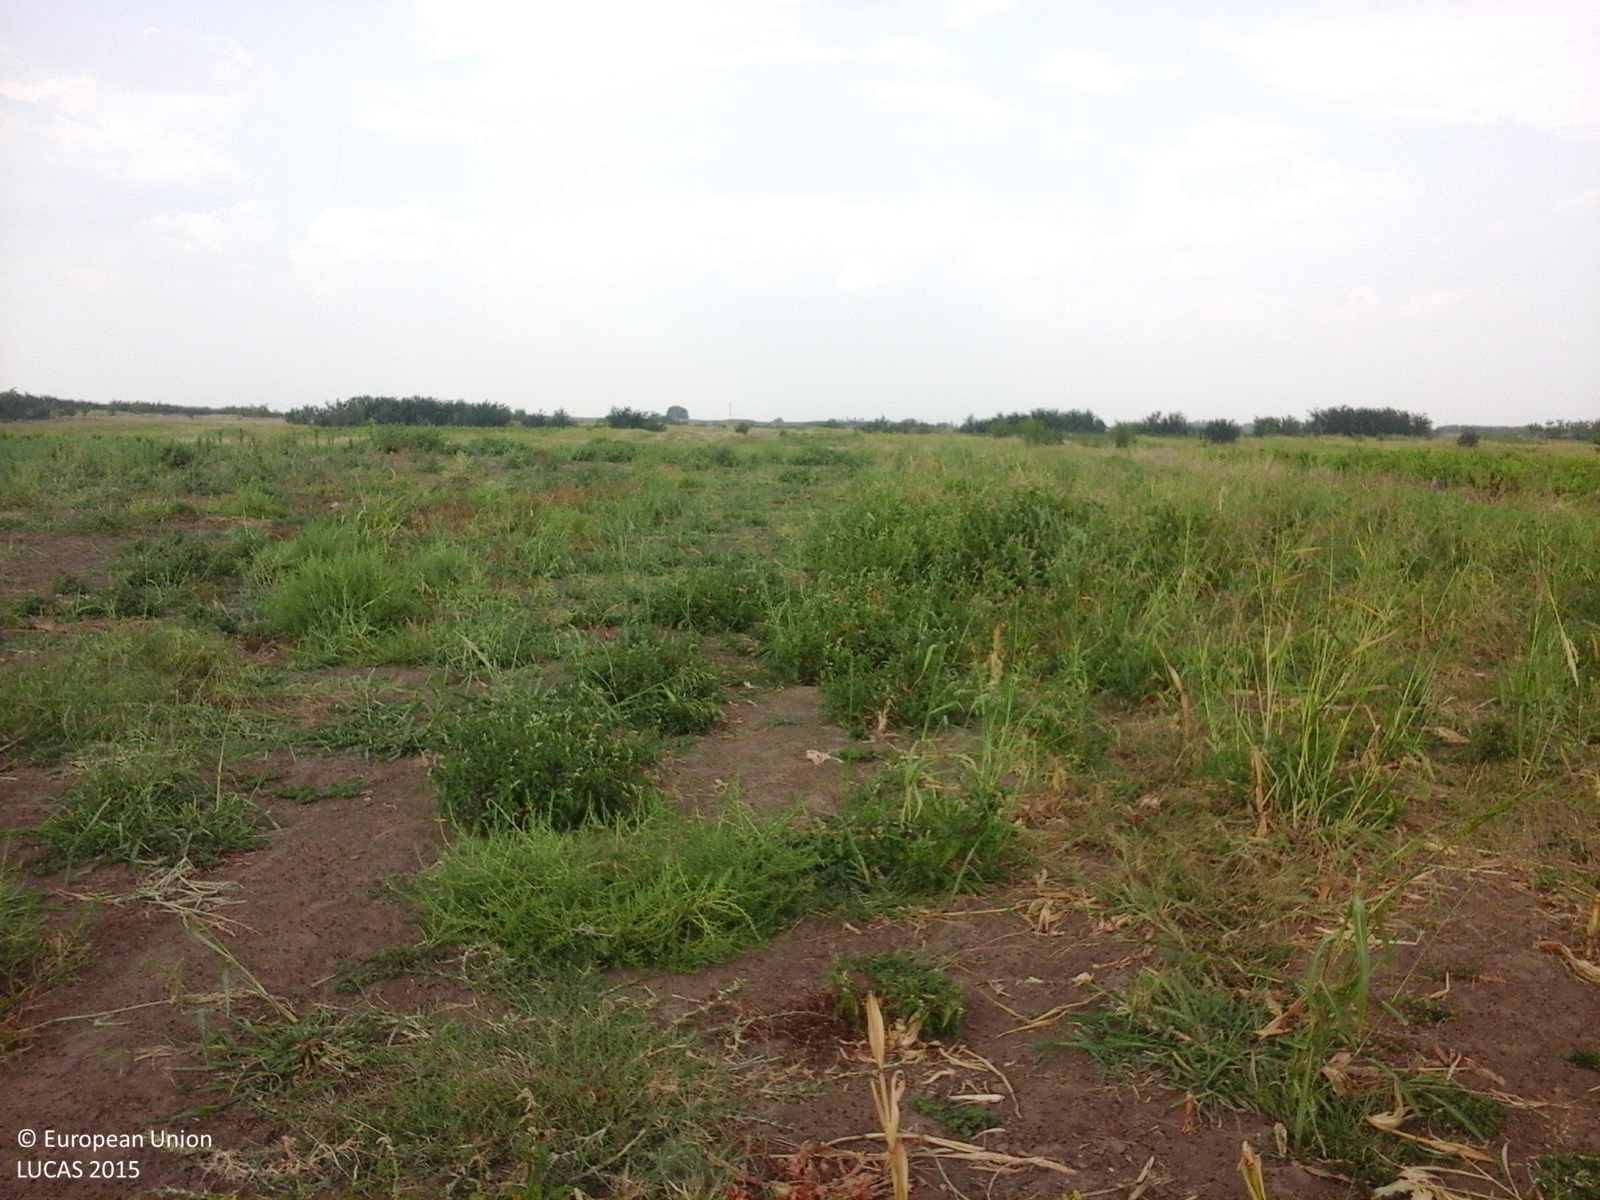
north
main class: Grassland
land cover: Spontaneously vegetated surfaces
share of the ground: 50 - 75 %
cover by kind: herbaceous plants 75 %, consolidated bare surface 25 %
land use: Agriculture (excluding fallow land and kitchen gardens)
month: August
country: RO
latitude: 43.9054
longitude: 23.0528
